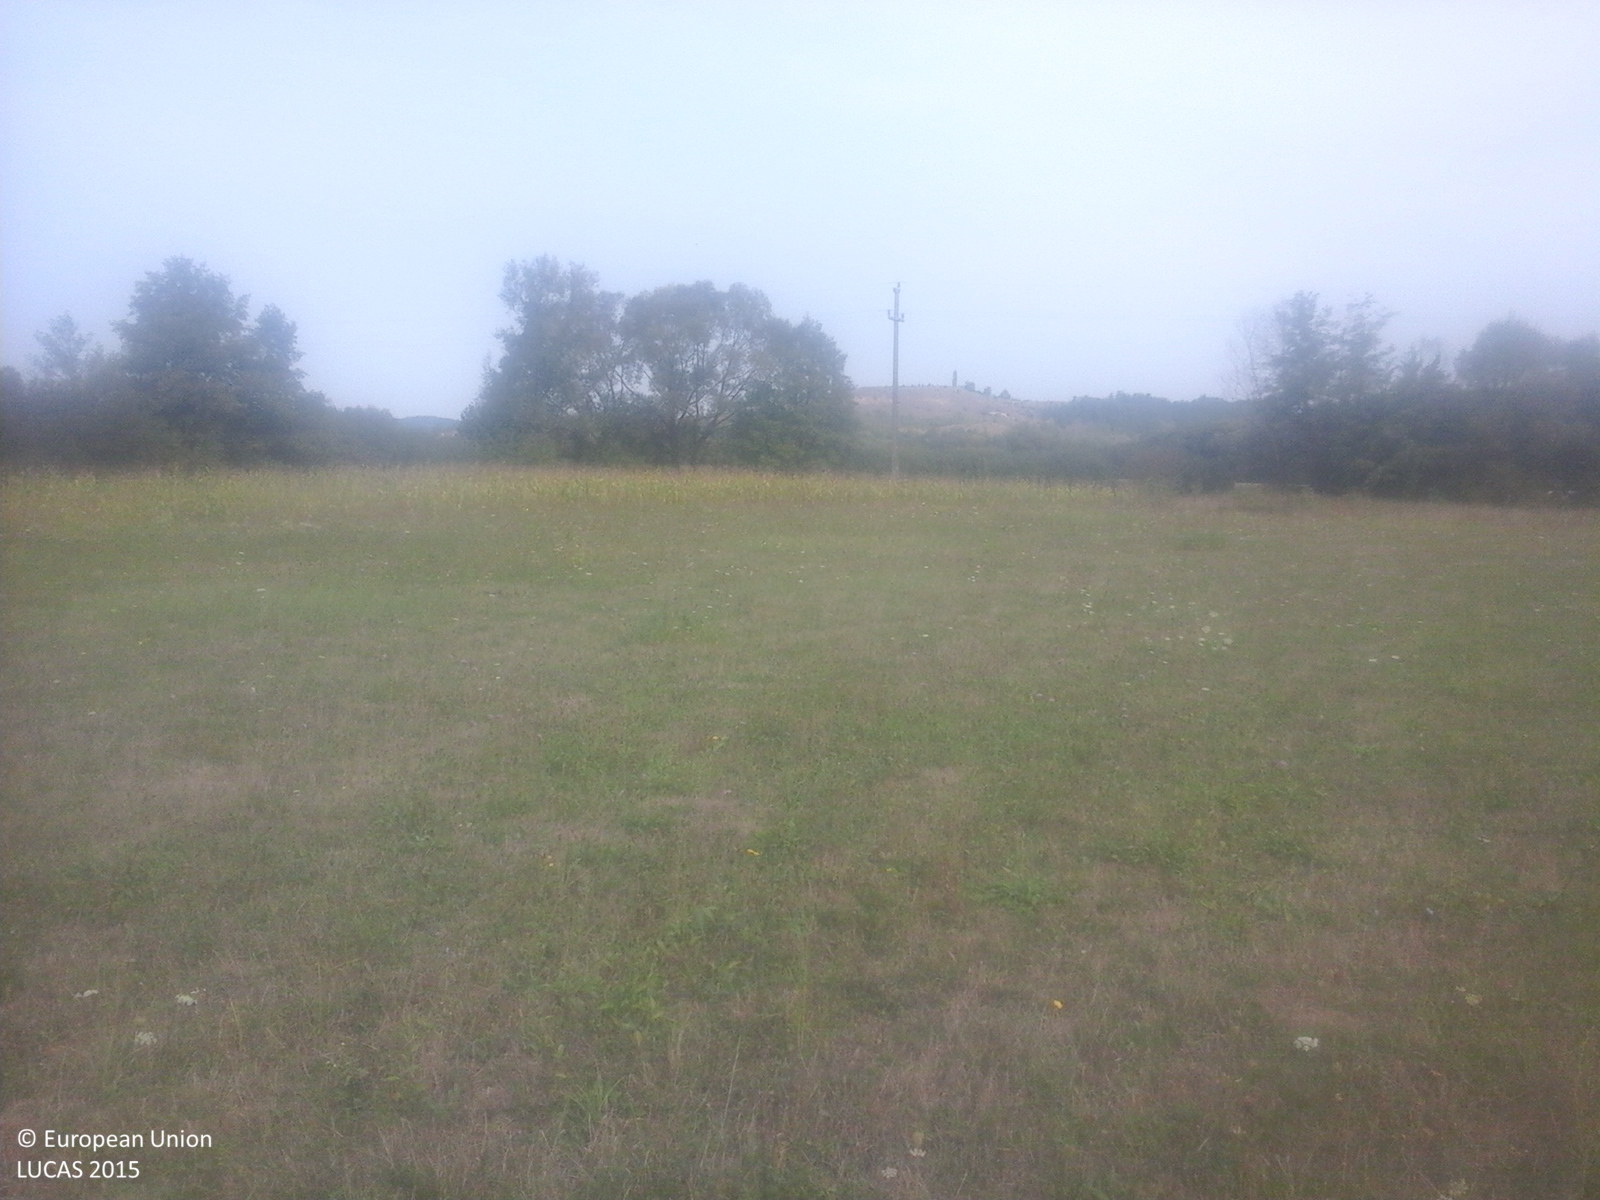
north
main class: Grassland
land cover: Grassland without tree/shrub cover
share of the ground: > 75 %
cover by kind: herbaceous plants 100 %
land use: Agriculture (excluding fallow land and kitchen gardens)
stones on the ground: < 10 %
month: September
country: RO
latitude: 45.4402
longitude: 21.9653
